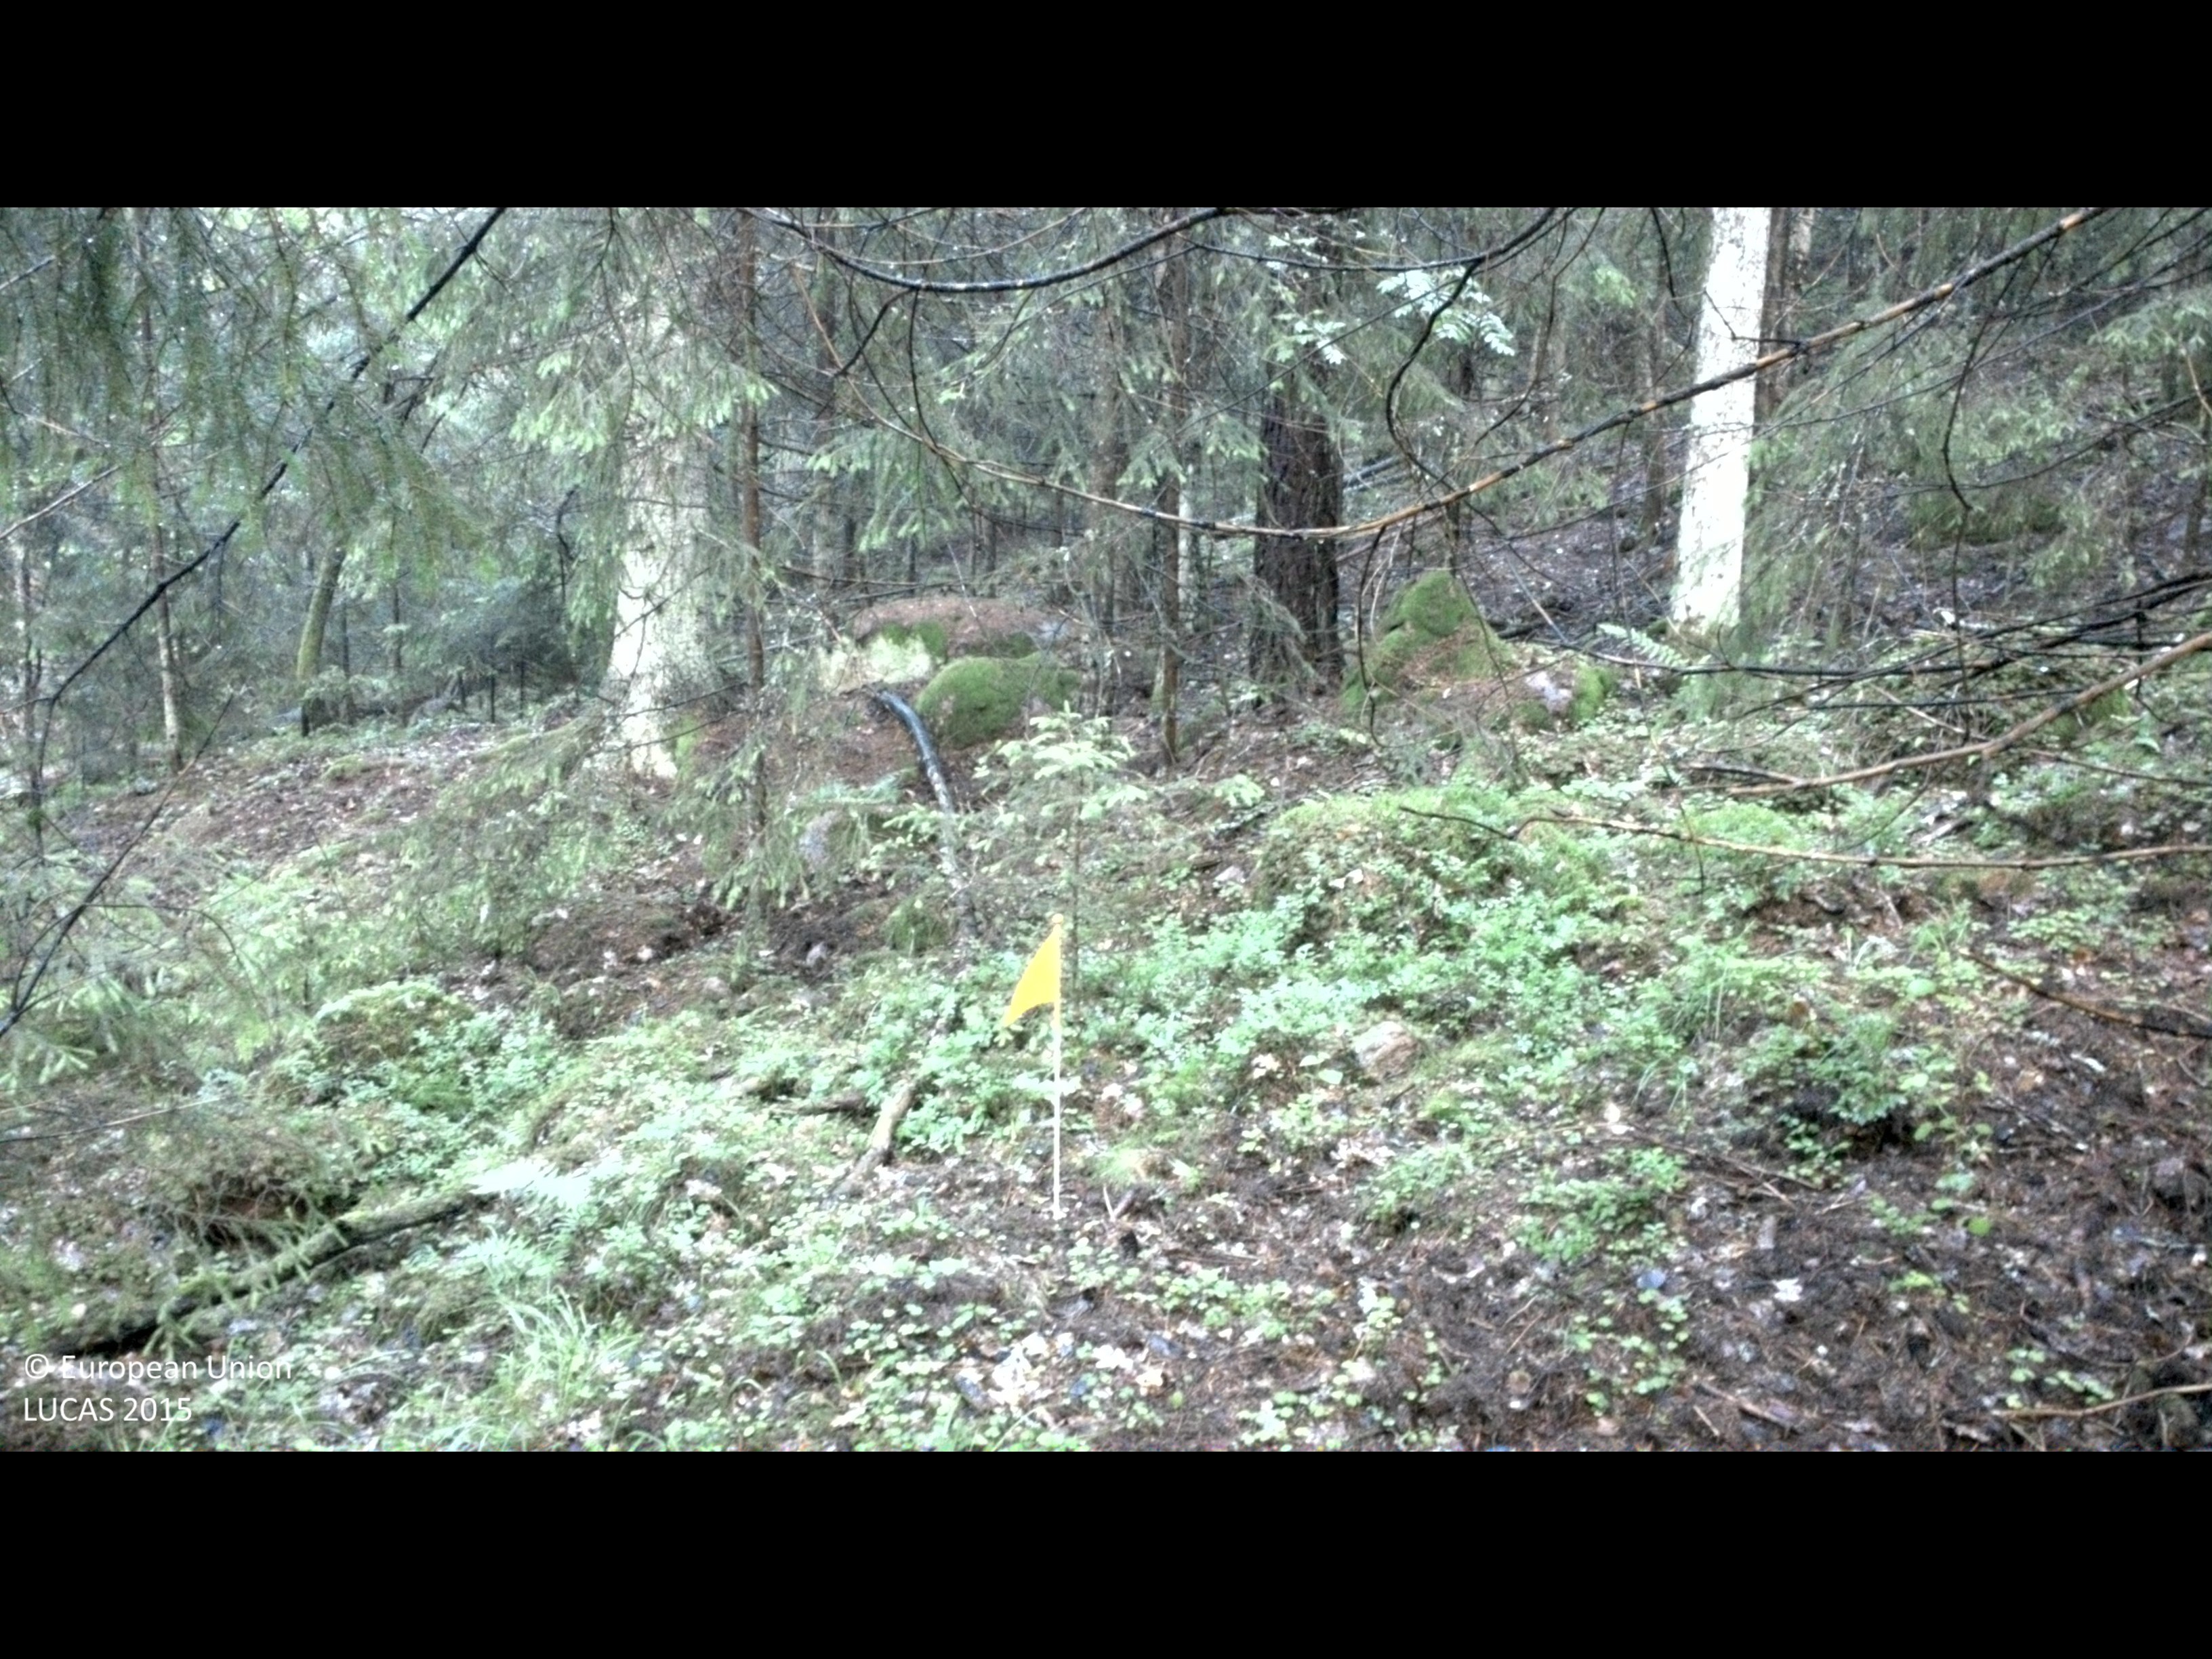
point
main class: Woodland
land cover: Other mixed woodland
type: boreal forest
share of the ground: > 75 %
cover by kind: coniferous forest trees 45 %, broadleaved forest trees 35 %, shrubs 10 %, lichens and mosses 10 %
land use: Forestry
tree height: > 5 m
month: June
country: SE
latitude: 57.9129
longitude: 16.2253
